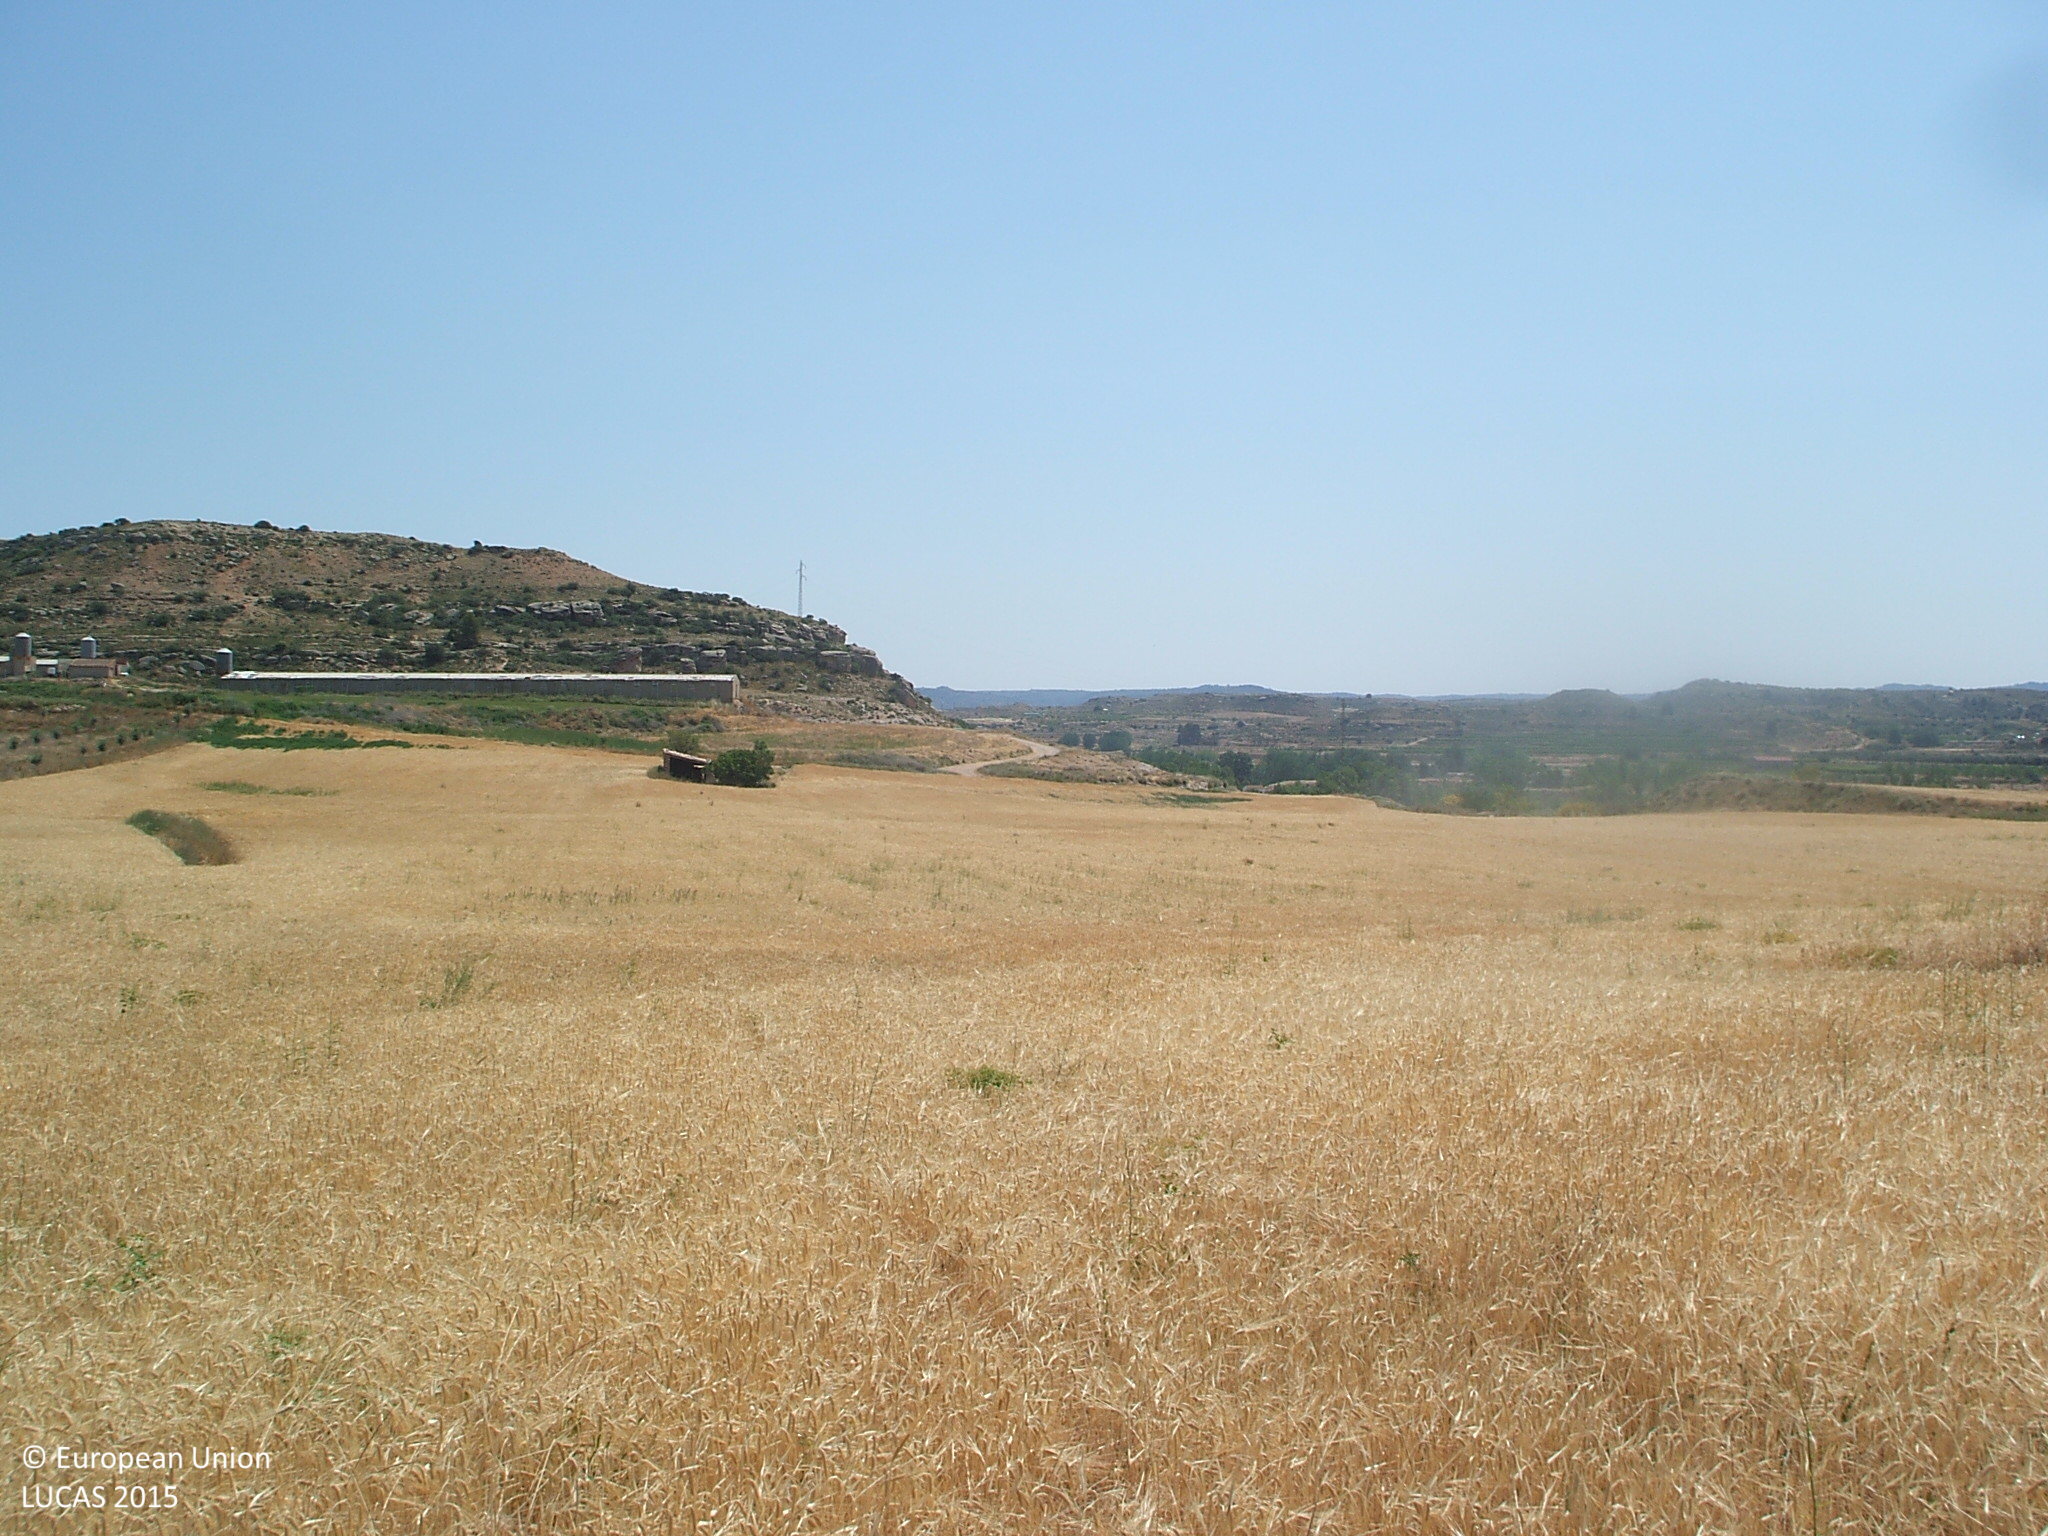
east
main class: Cropland
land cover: Barley
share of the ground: > 75 %
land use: Agriculture (excluding fallow land and kitchen gardens)
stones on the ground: > 50 %
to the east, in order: Barley
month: June
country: ES
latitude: 40.9760
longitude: -0.1719
